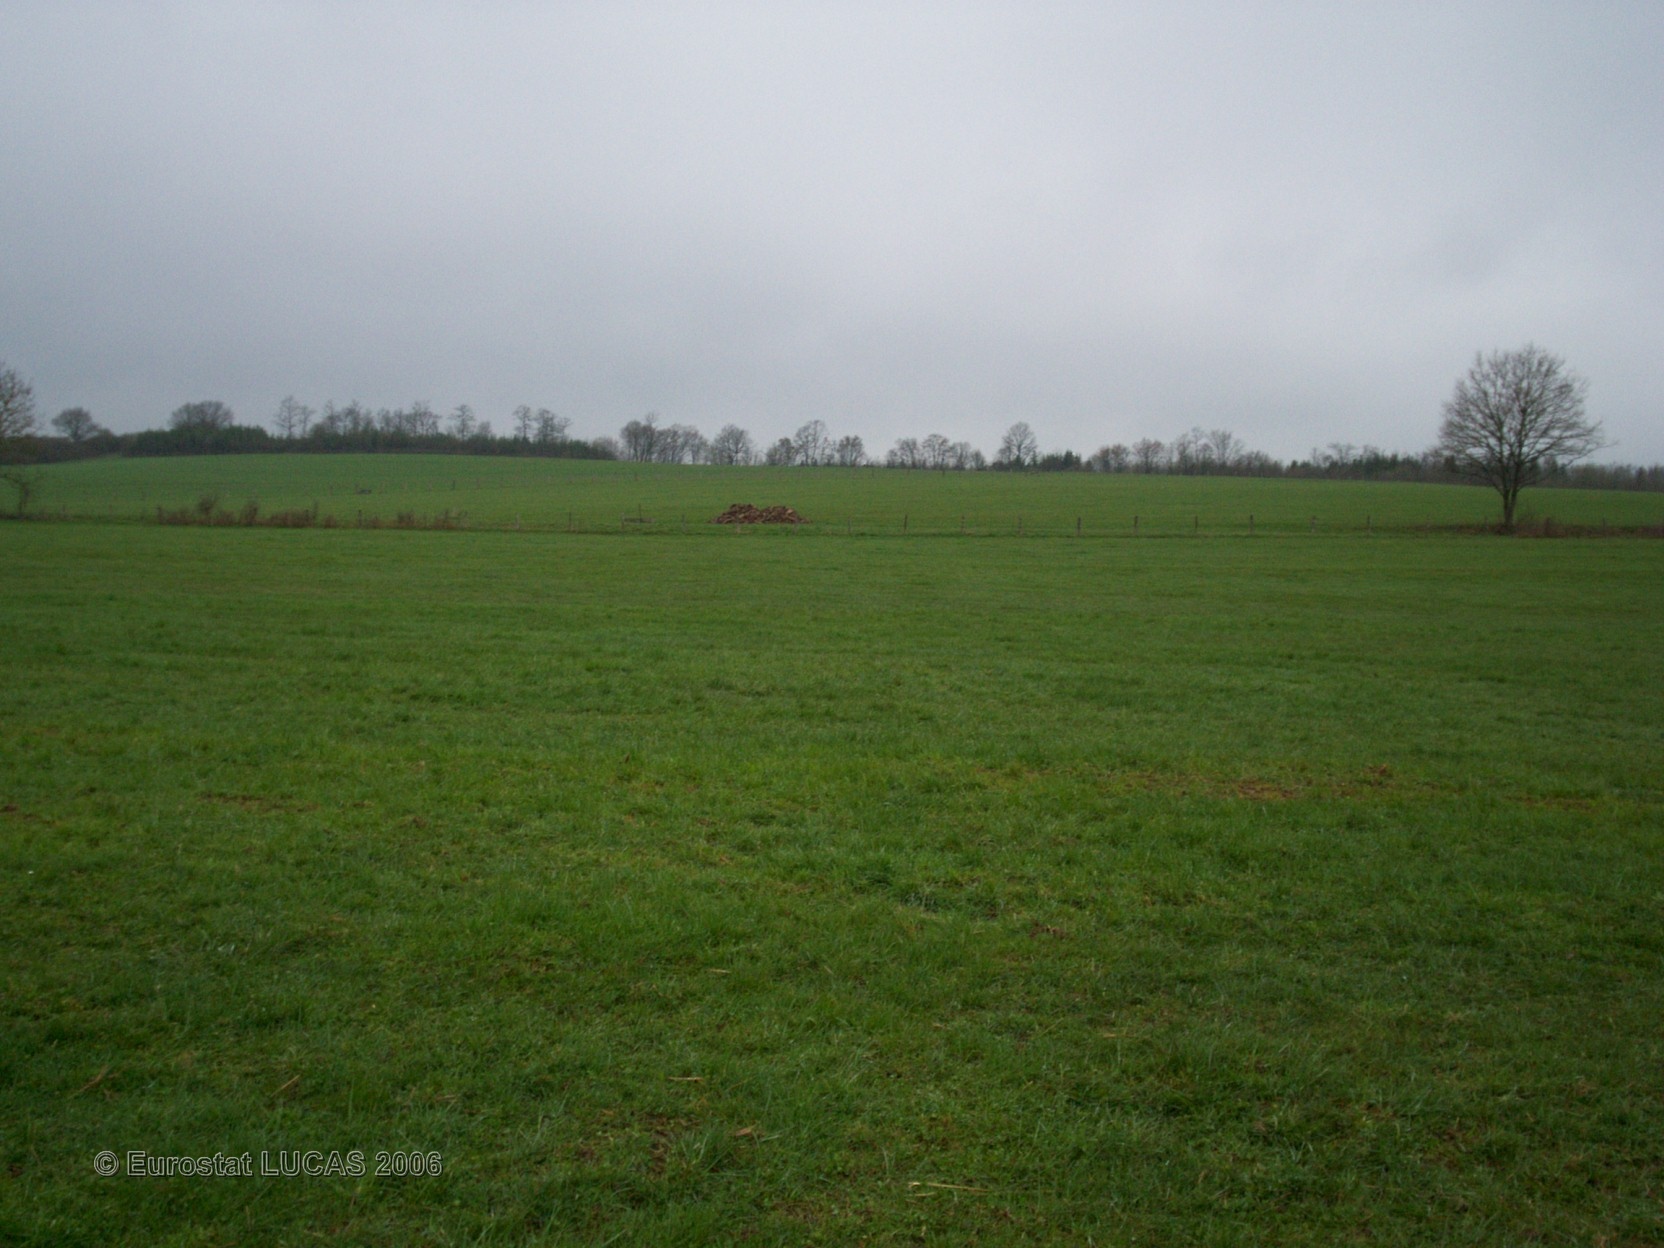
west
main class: Grassland
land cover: Grassland without tree/shrub cover
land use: Agriculture (excluding fallow land and kitchen gardens)
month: April
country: FR
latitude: 48.1778
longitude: 6.2484
